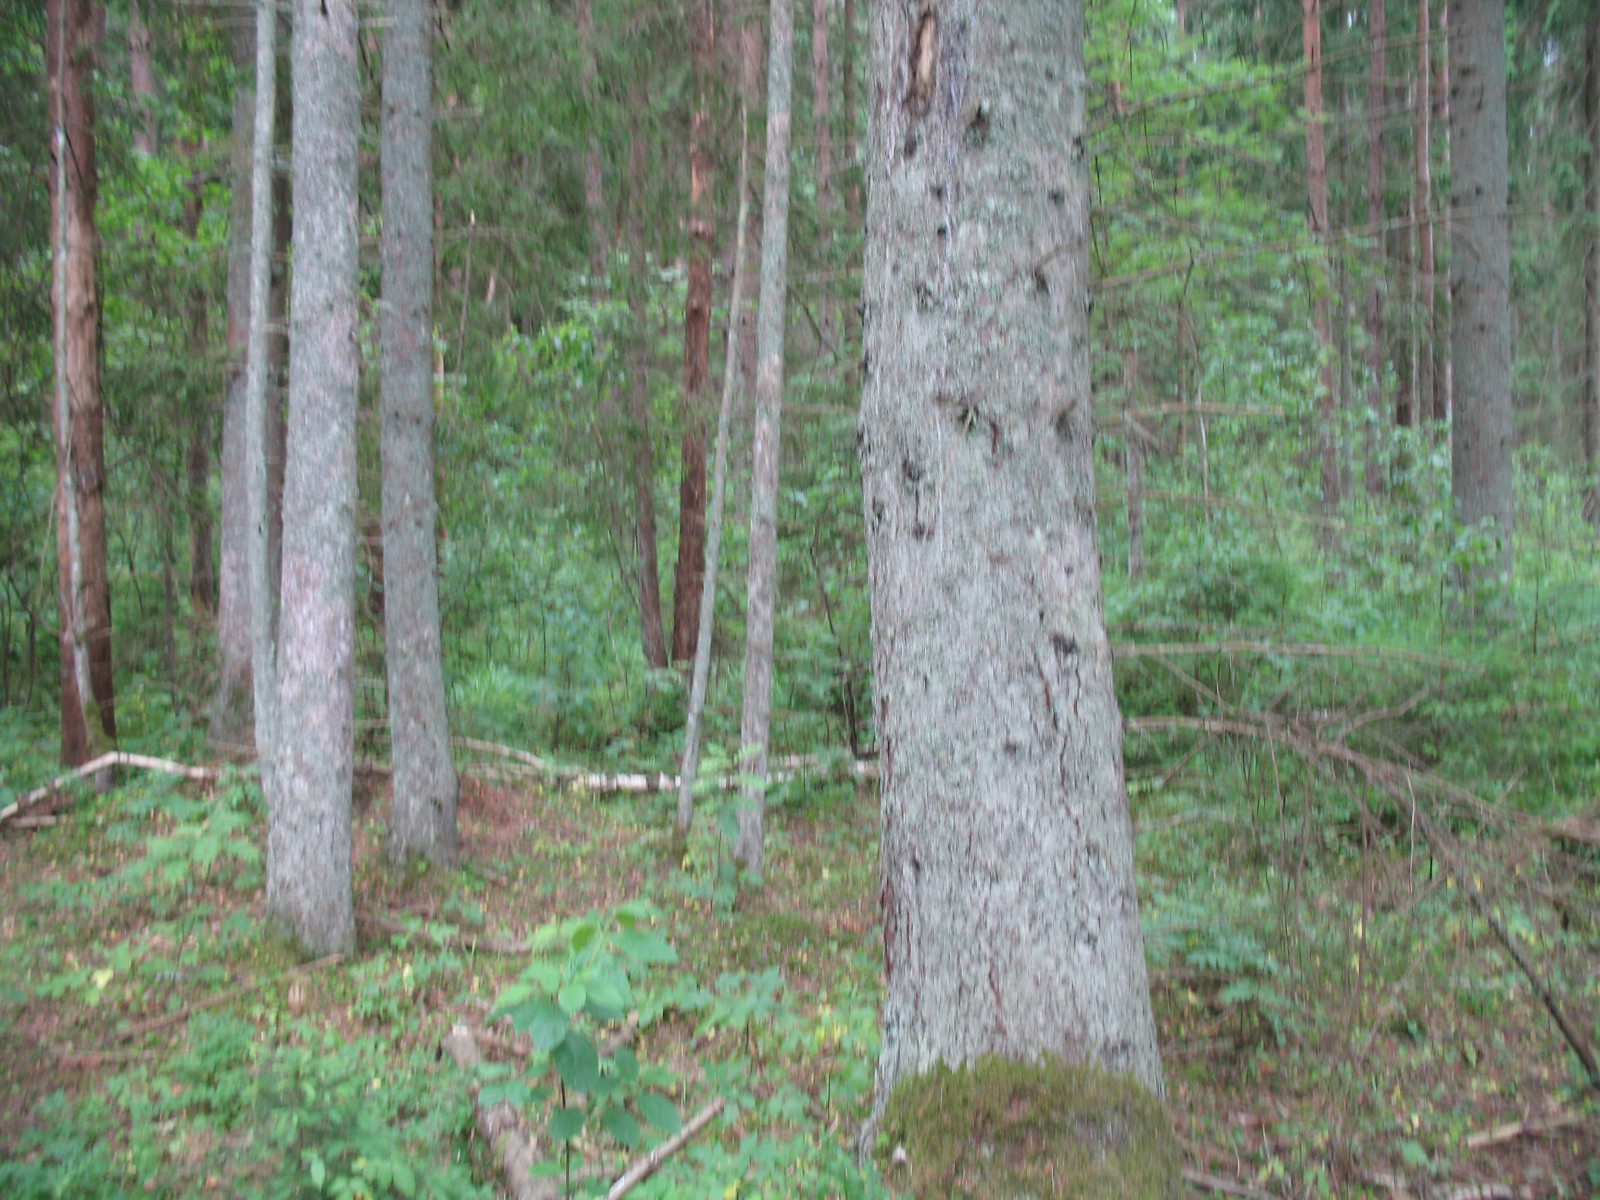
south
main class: Woodland
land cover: Other coniferous woodland
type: hemiboreal forest and nemoral coniferous forest and mixed broadleaved-coniferous forest
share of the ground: > 75 %
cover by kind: coniferous forest trees 80 %, broadleaved forest trees 10 %, herbaceous plants 5 %, lichens and mosses 5 %
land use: Forestry
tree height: > 5 m
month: July
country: LV
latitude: 56.7495
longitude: 23.8334
